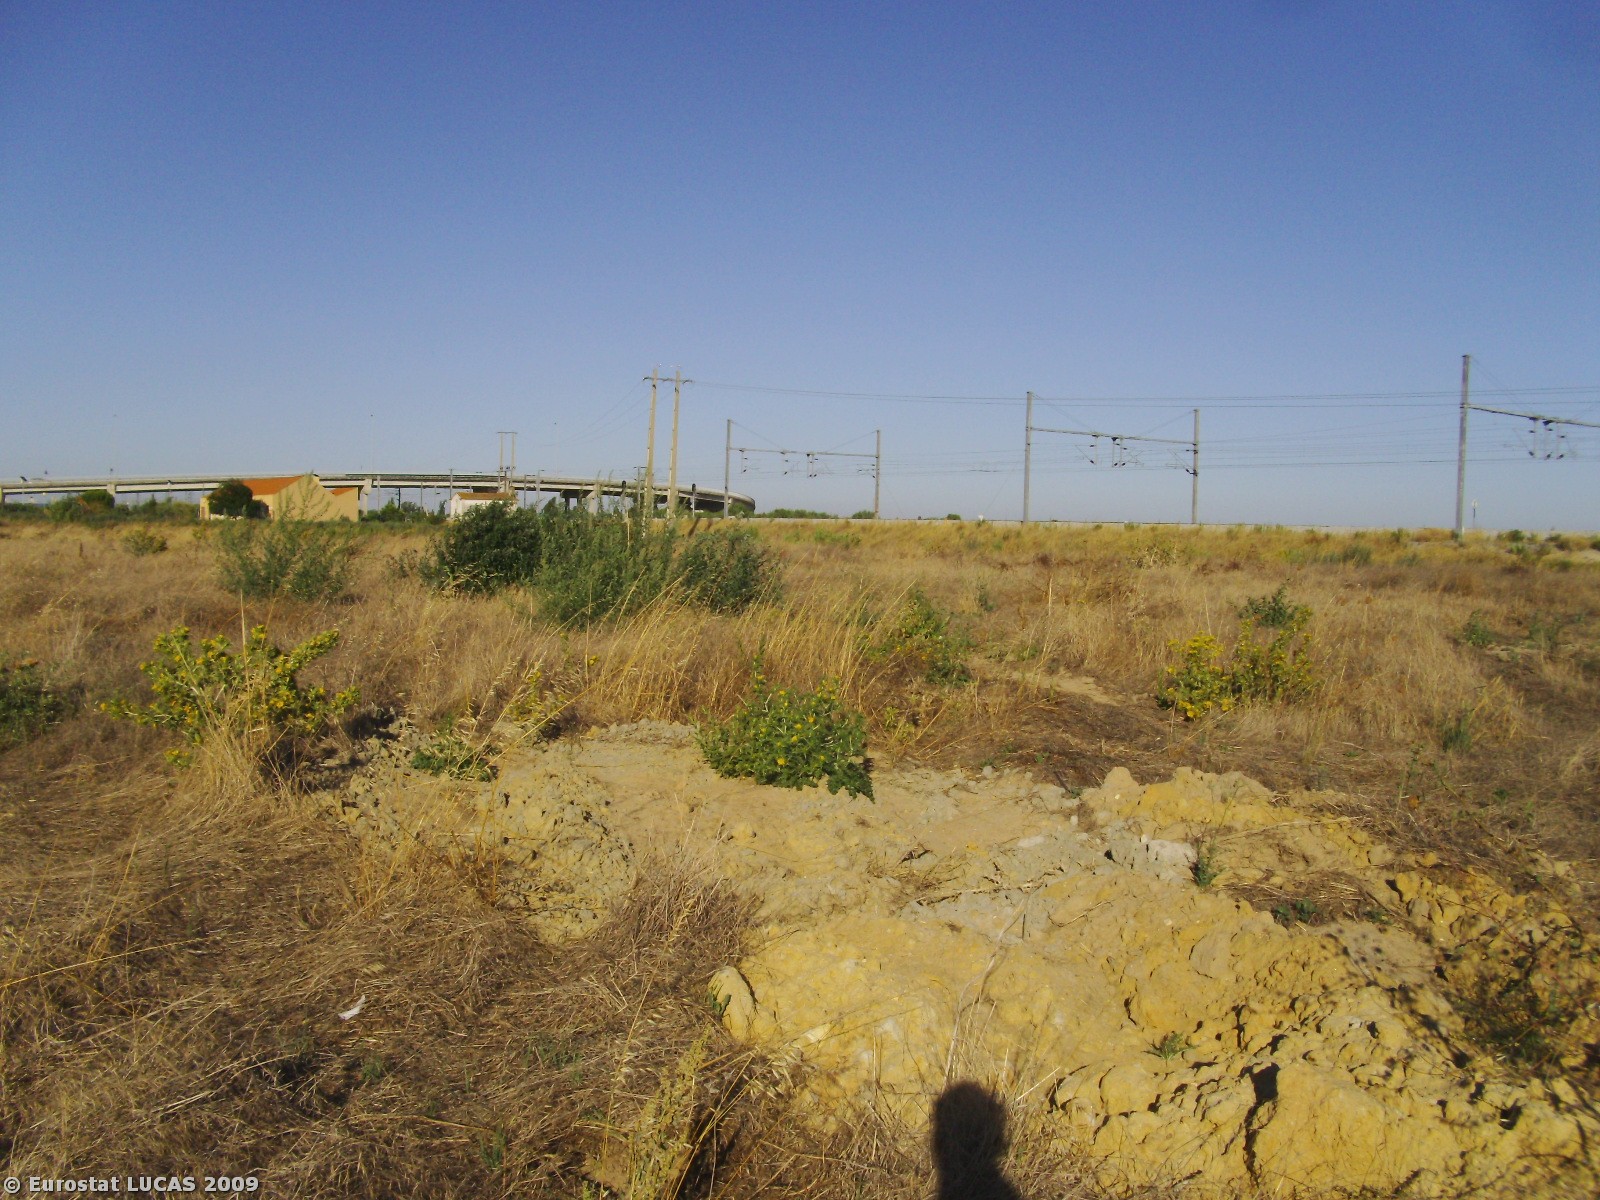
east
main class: Grassland
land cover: Spontaneously vegetated surfaces
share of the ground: > 75 %
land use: Fallow land
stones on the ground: 10 - 25 %
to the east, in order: Spontaneously vegetated surfaces; Electric lines; Spontaneously vegetated surfaces; Fences; Spontaneously vegetated surfaces; Railways; Fences; Grass margins; Tracks; Arable land (only in case pi)
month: July
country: PT
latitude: 39.0640
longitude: -8.8780
